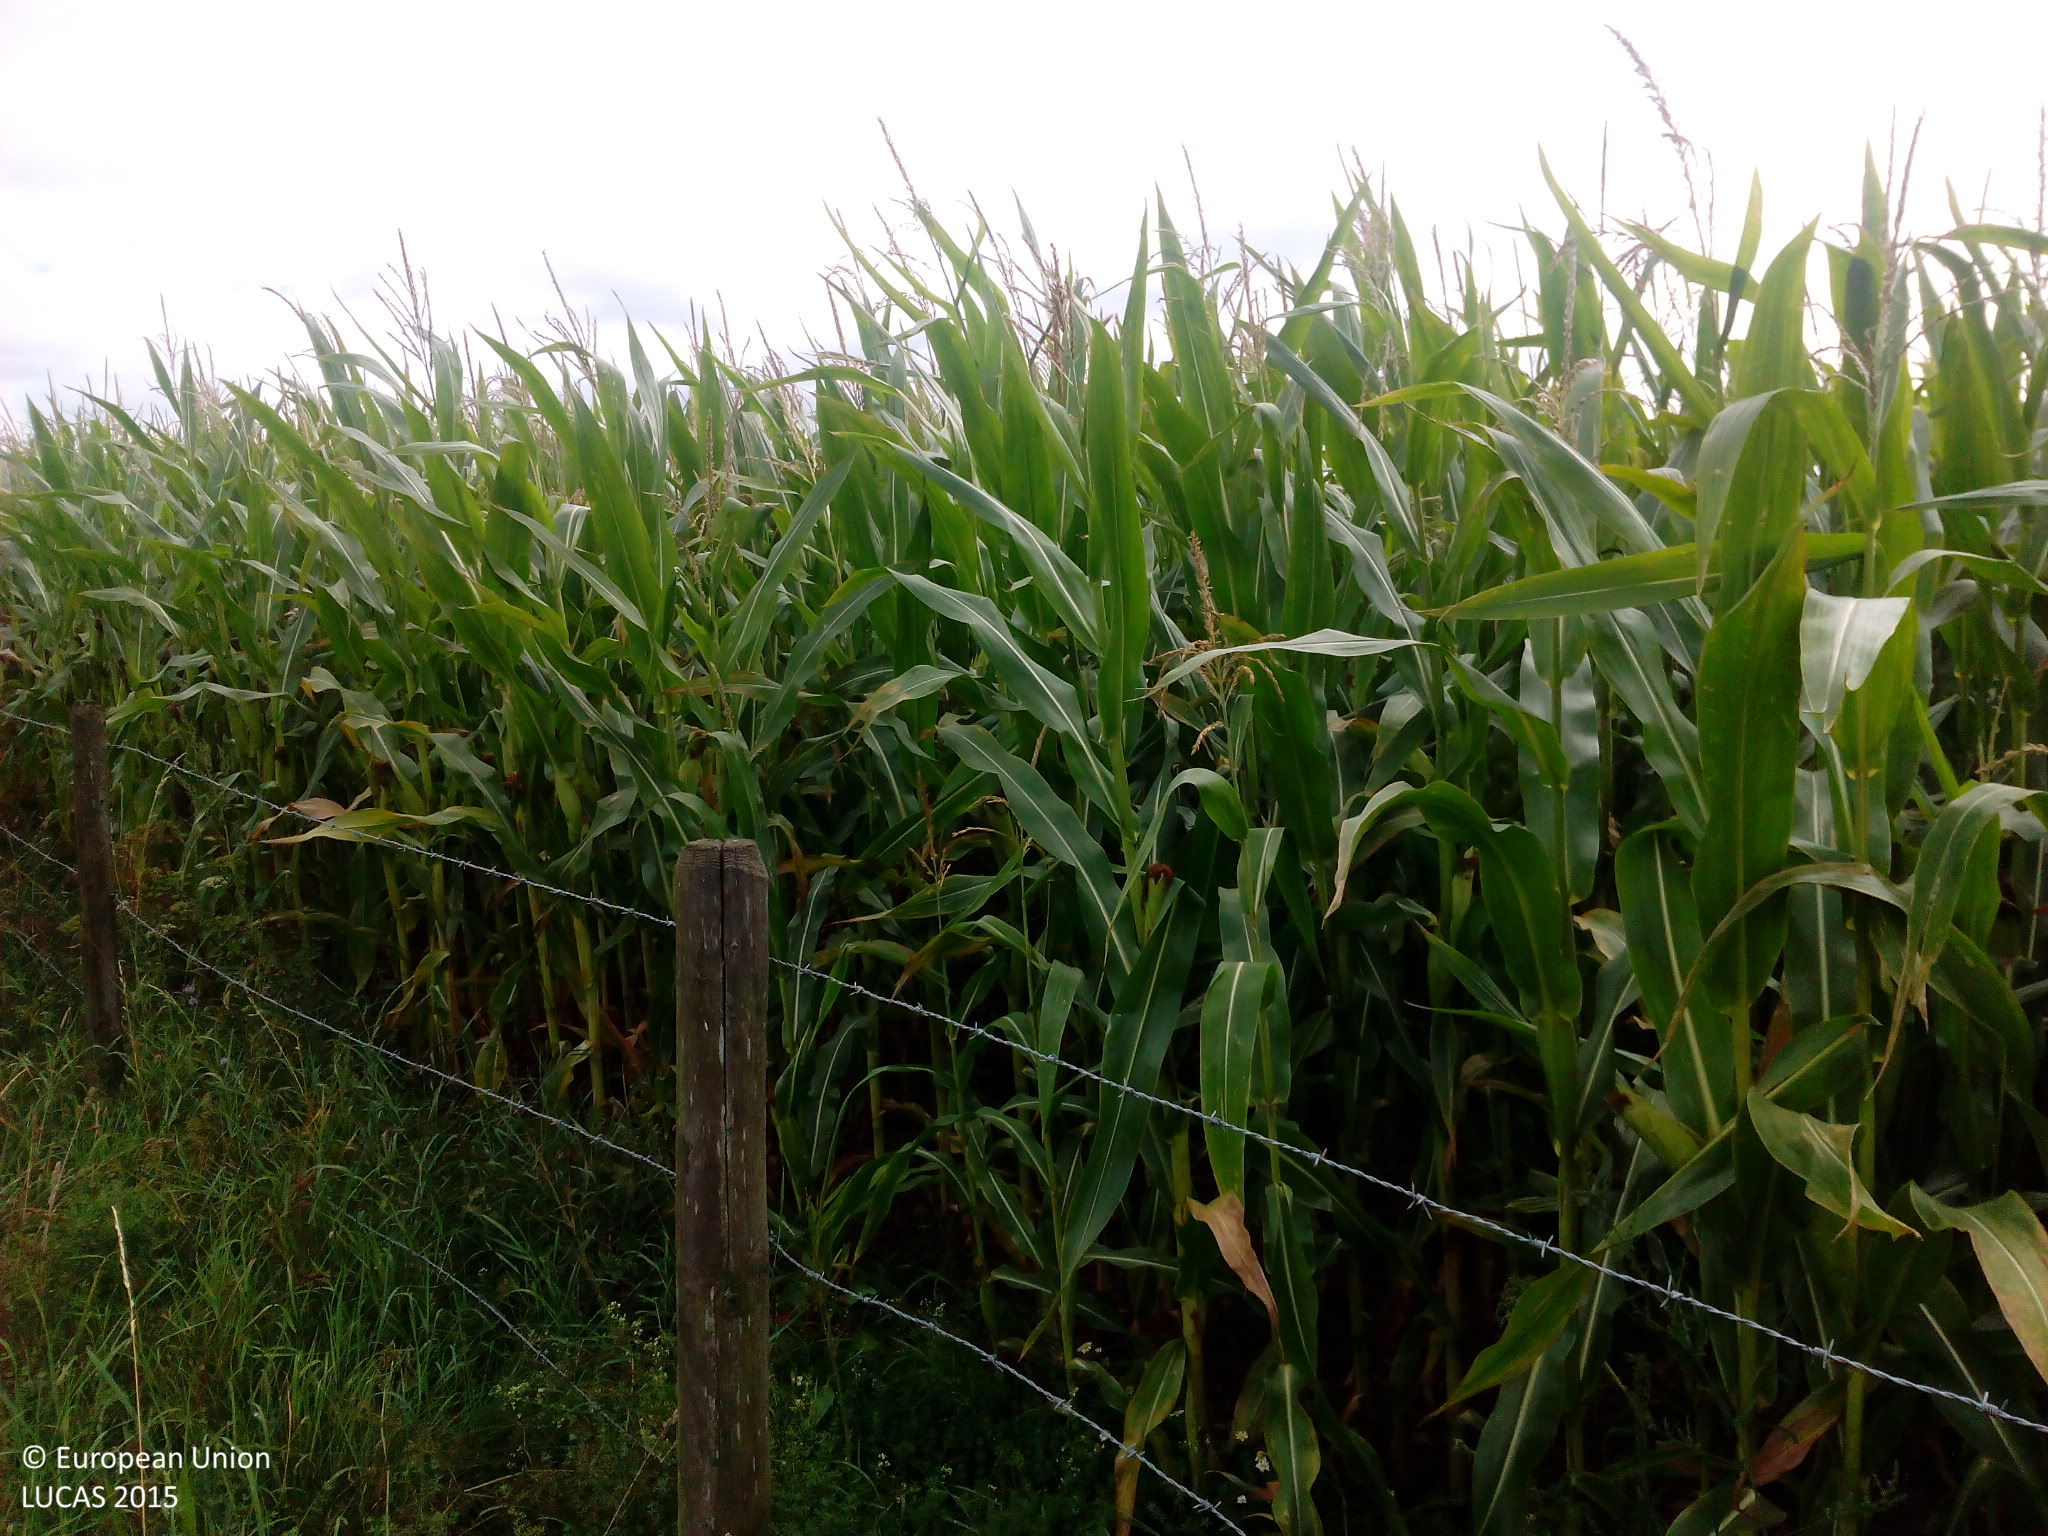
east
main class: Cropland
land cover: Maize
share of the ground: > 75 %
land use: Agriculture (excluding fallow land and kitchen gardens)
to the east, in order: Maize; Rye; Temporary grasslands; Tracks; Broadleaved woodland; Tracks; Grassland without tree/shrub cover; Paved roads, cycling and walking lanes; Grassland without tree/shrub cover
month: August
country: DE
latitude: 50.2497
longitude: 6.2830
